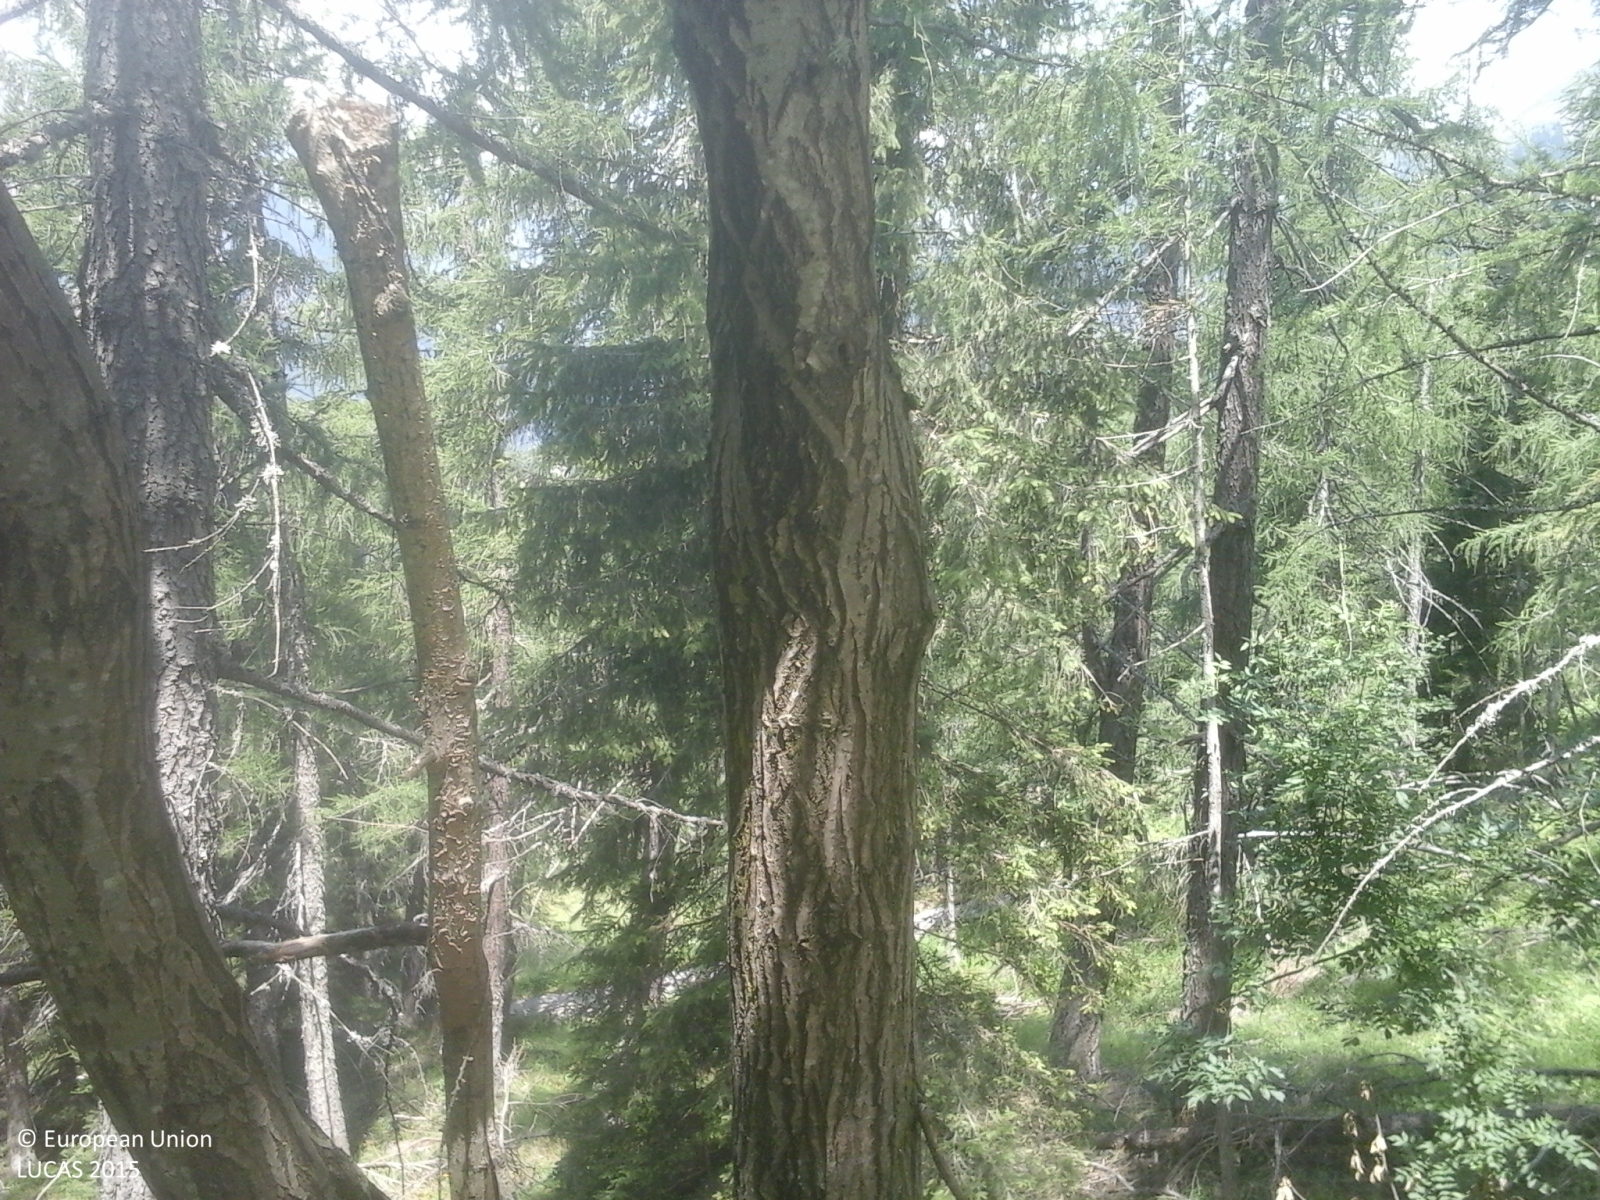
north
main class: Woodland
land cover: Spruce dominated mixed woodland
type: alpine coniferous forest
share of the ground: > 75 %
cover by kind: coniferous forest trees 75 %, broadleaved forest trees 25 %
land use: Forestry
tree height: > 5 m
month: July
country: IT
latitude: 46.3853
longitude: 9.3637
